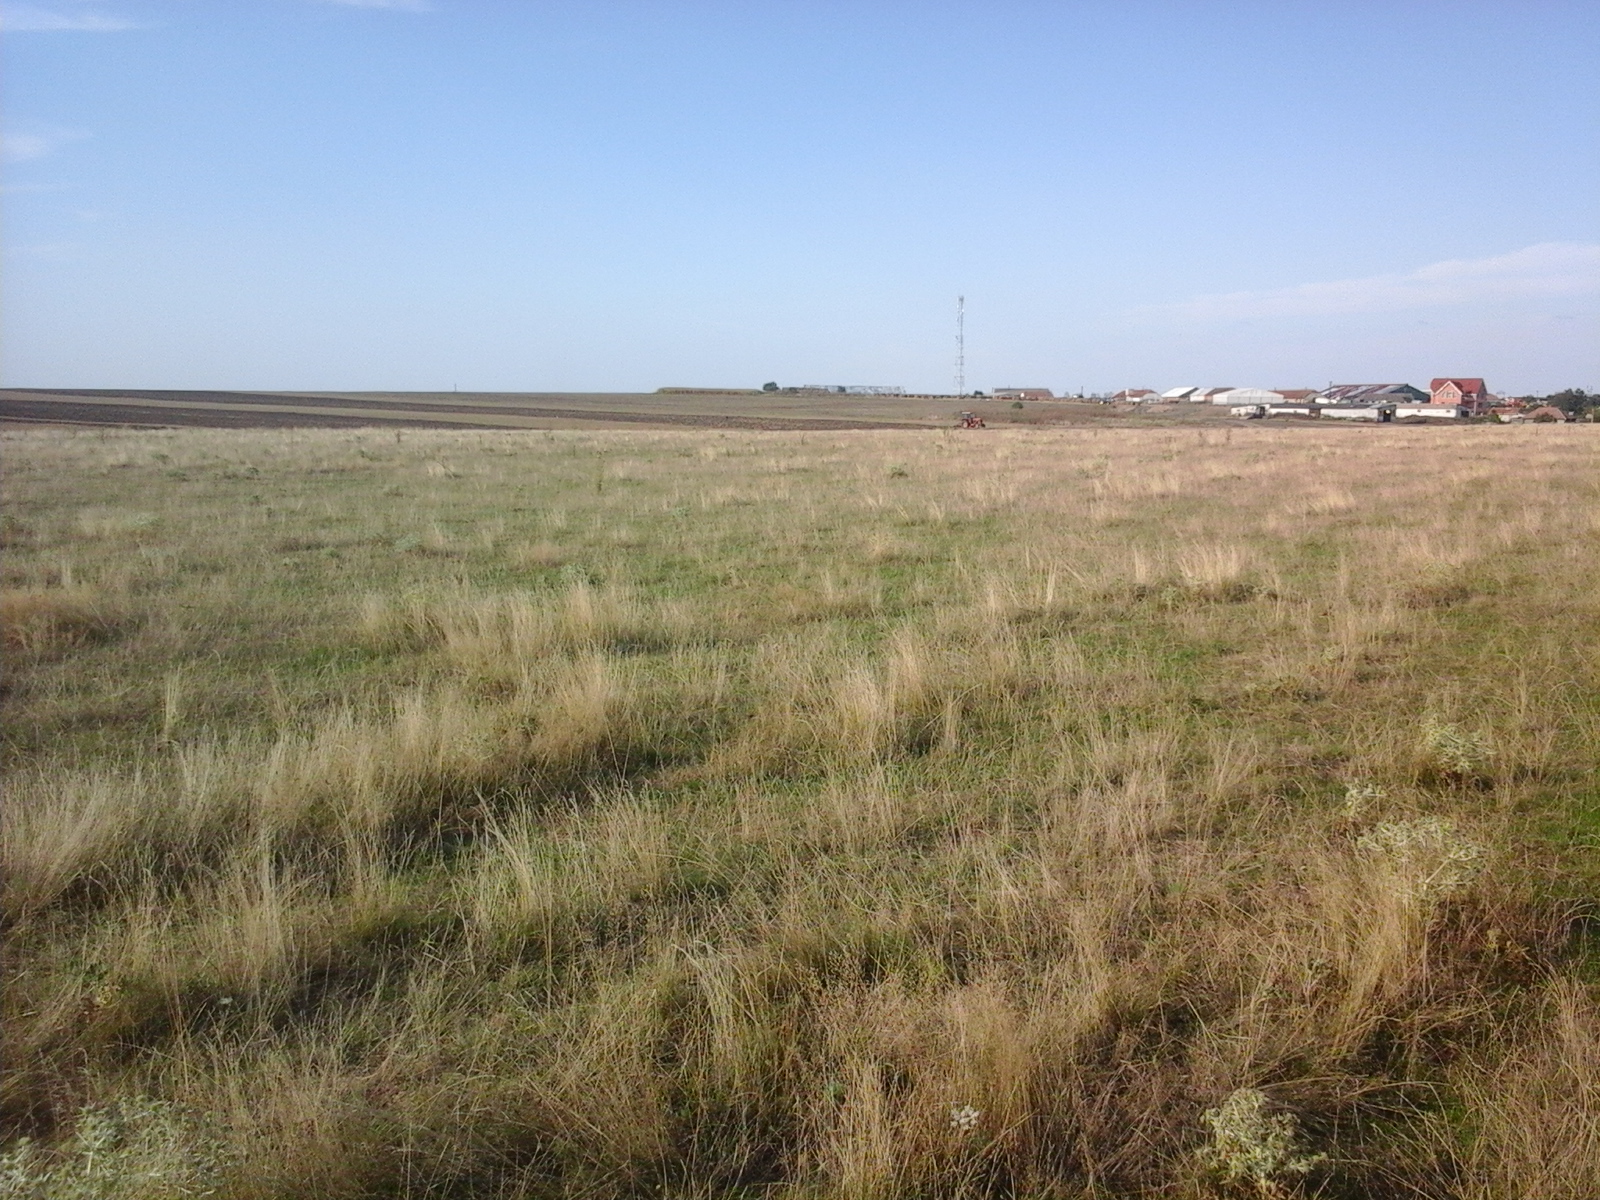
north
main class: Grassland
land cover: Grassland without tree/shrub cover
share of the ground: > 75 %
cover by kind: herbaceous plants 100 %
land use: Agriculture (excluding fallow land and kitchen gardens)
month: August
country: RO
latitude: 46.0165
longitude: 21.3611
